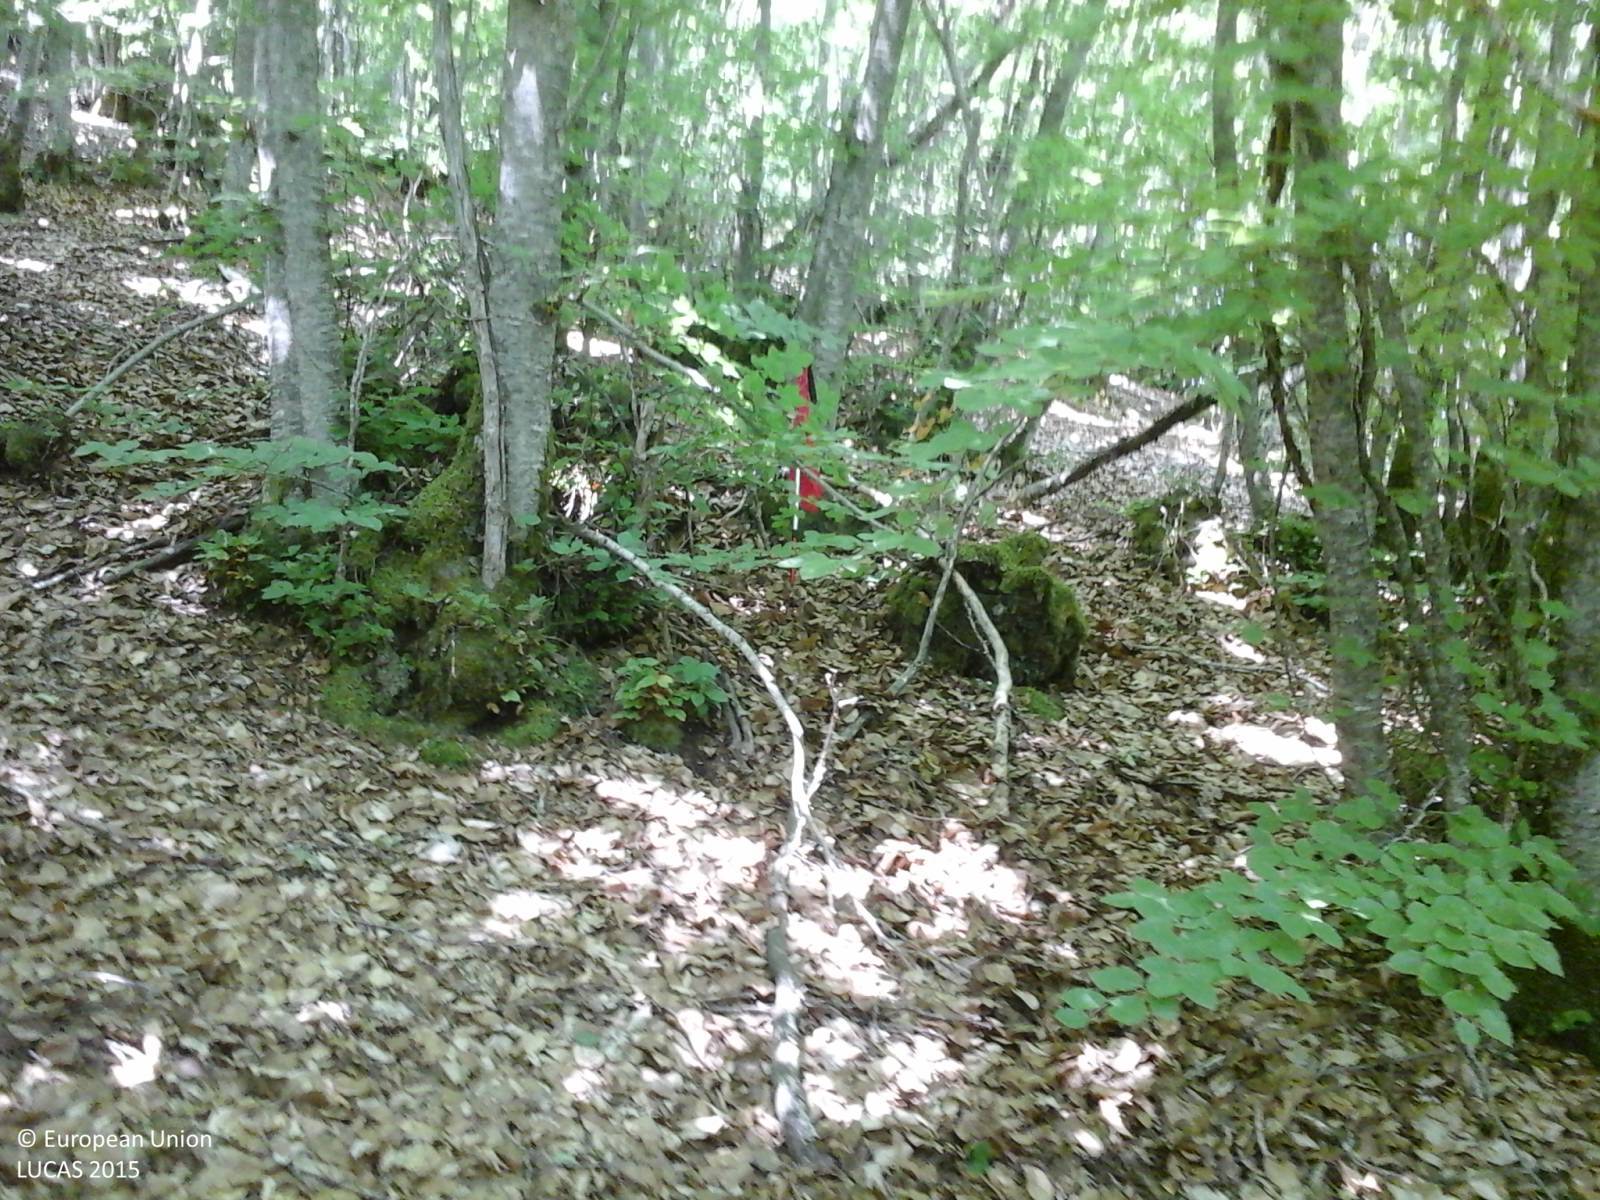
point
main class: Woodland
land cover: Broadleaved woodland
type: mountainous beech forest
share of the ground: > 75 %
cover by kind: broadleaved forest trees 100 %
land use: Forestry
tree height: > 5 m
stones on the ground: < 10 %
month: July
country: IT
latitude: 42.4232
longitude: 13.1861
